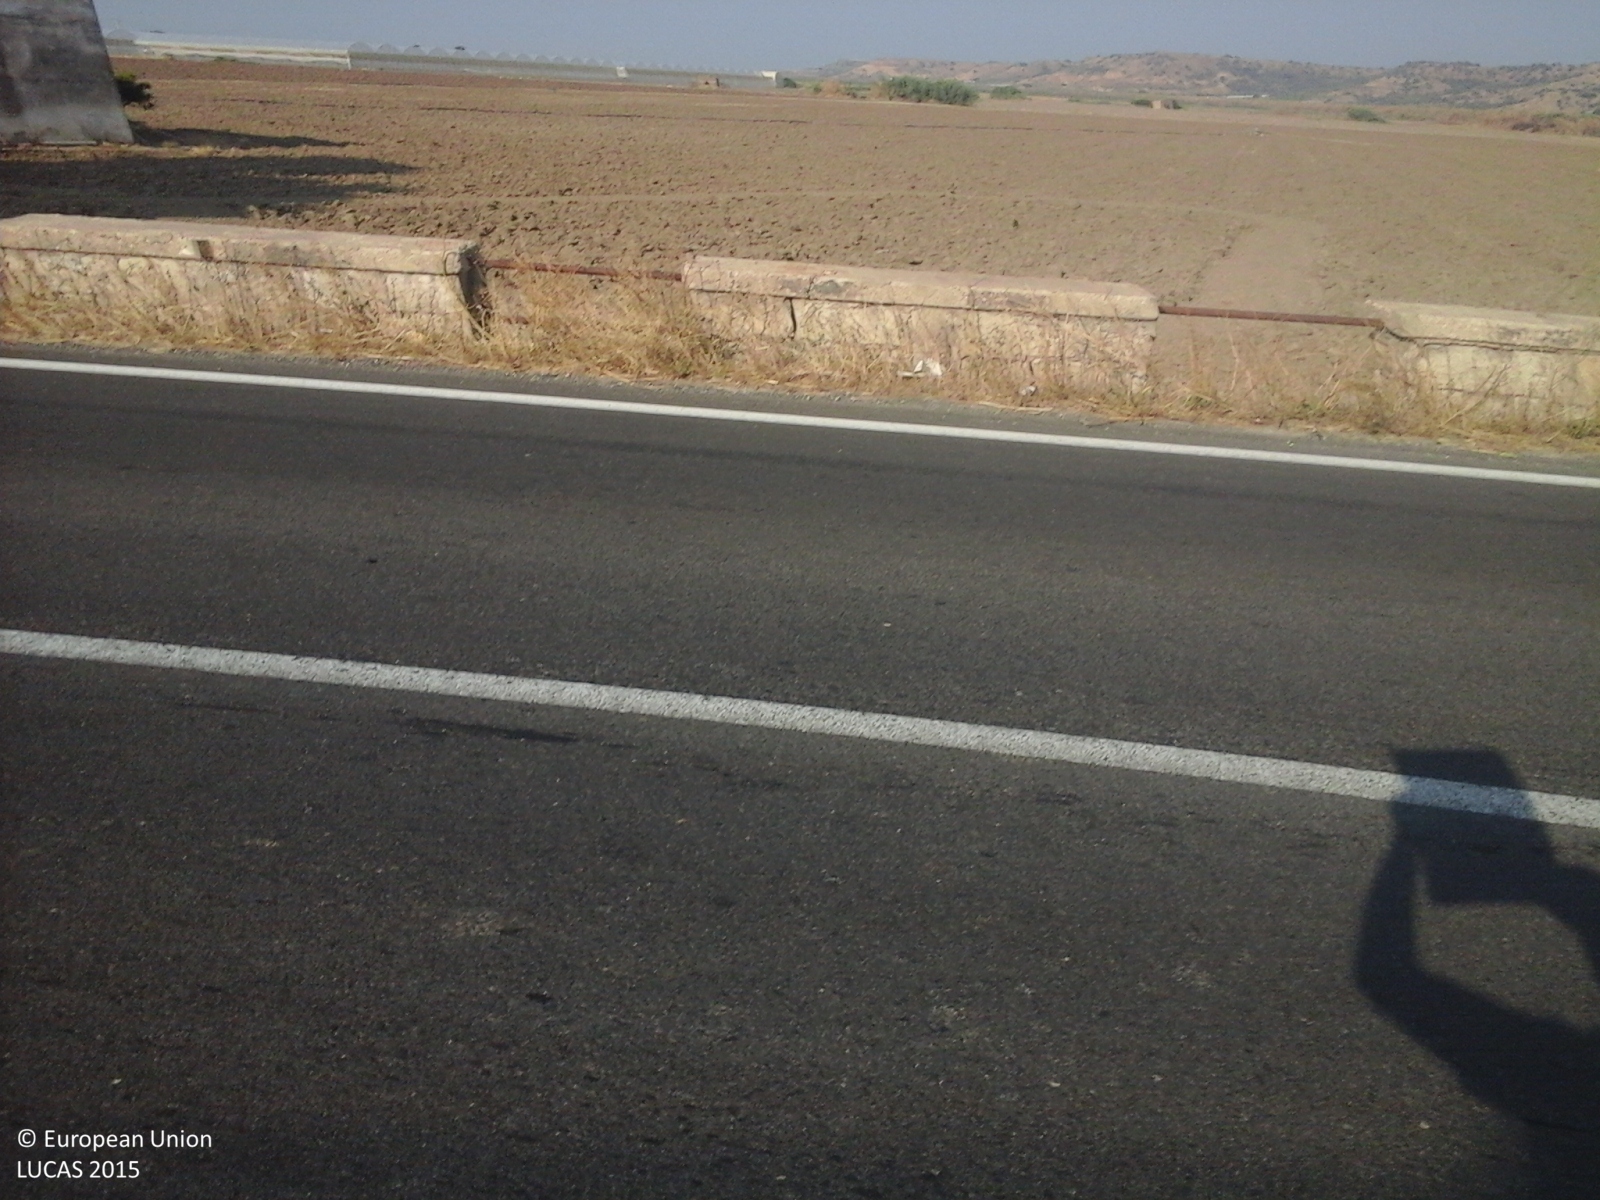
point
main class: Cropland
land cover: Durum wheat
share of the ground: > 75 %
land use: Agriculture (excluding fallow land and kitchen gardens)
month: July
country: IT
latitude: 37.0272
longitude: 14.4053
